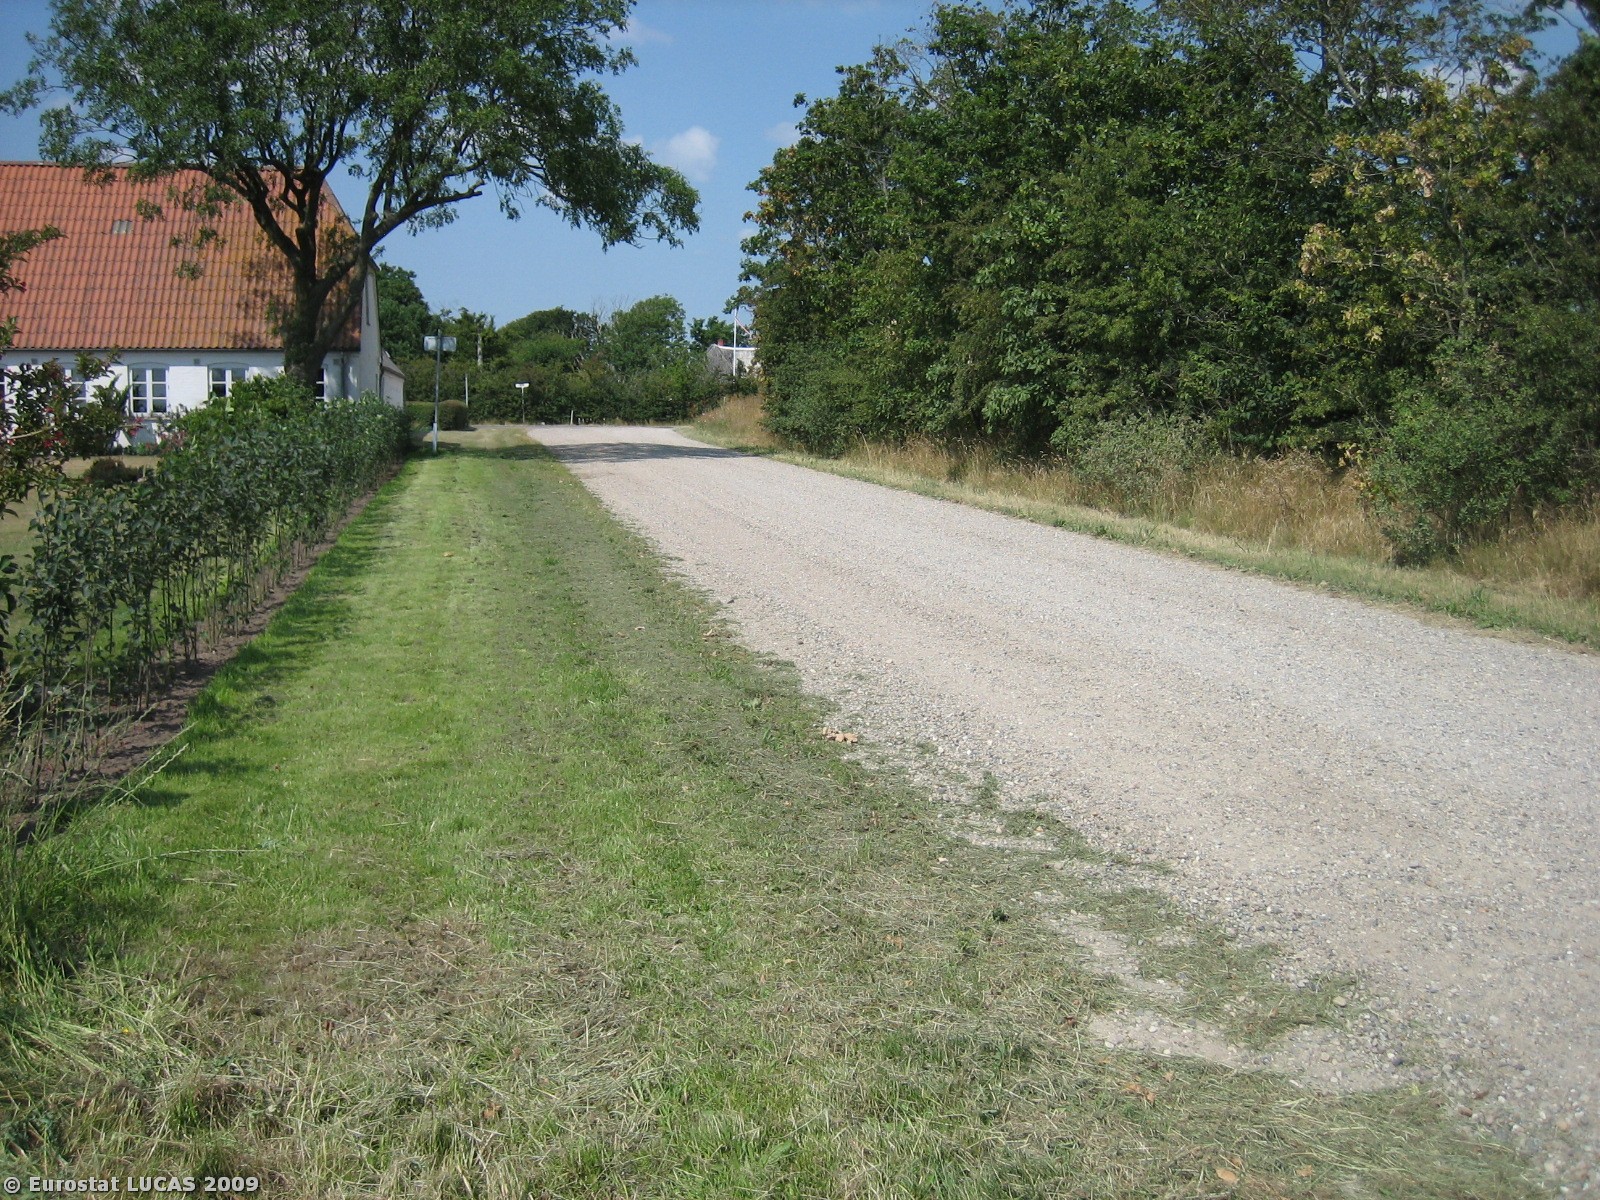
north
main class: Cropland
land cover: Common wheat
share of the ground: > 75 %
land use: Agriculture (excluding fallow land and kitchen gardens)
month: July
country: DK
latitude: 55.3904
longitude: 8.7224
